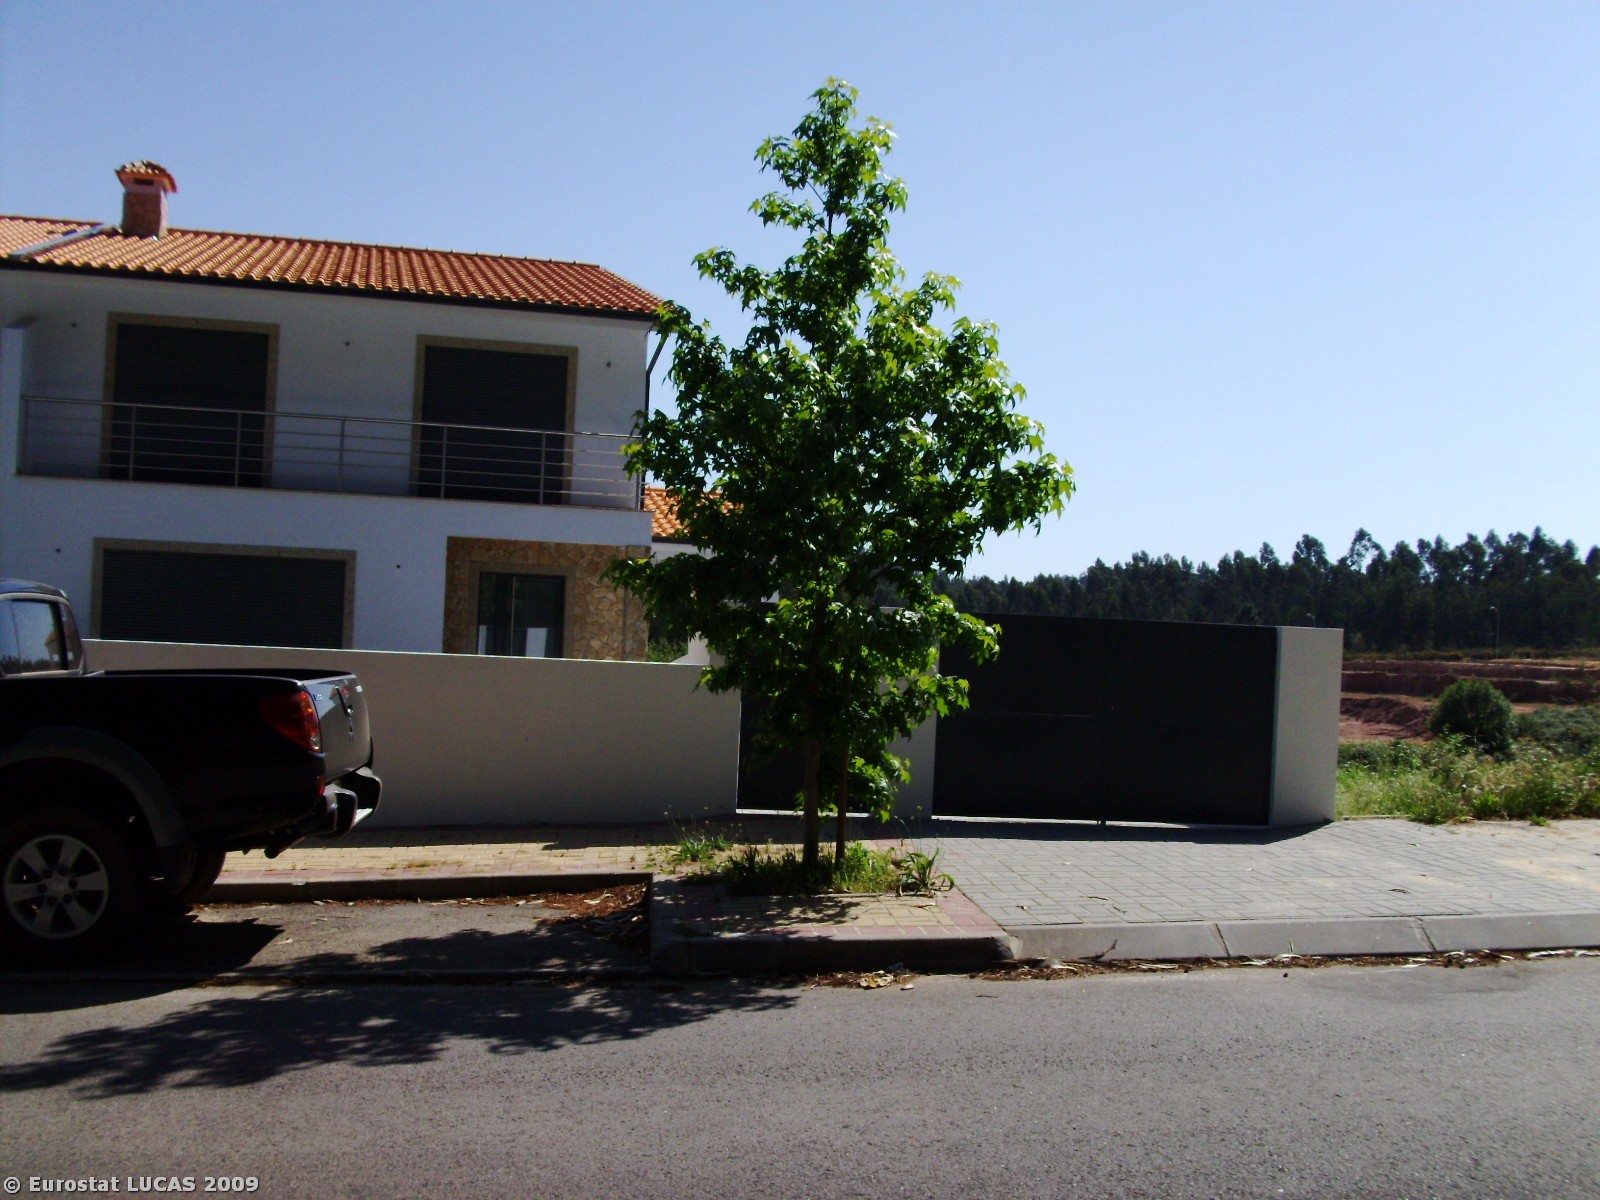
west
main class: Woodland
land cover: Coniferous woodland
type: coniferous forest of the mediterranean region
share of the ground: > 75 %
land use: Forestry
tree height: > 5 m
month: May
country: PT
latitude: 40.6096
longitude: -8.4460
